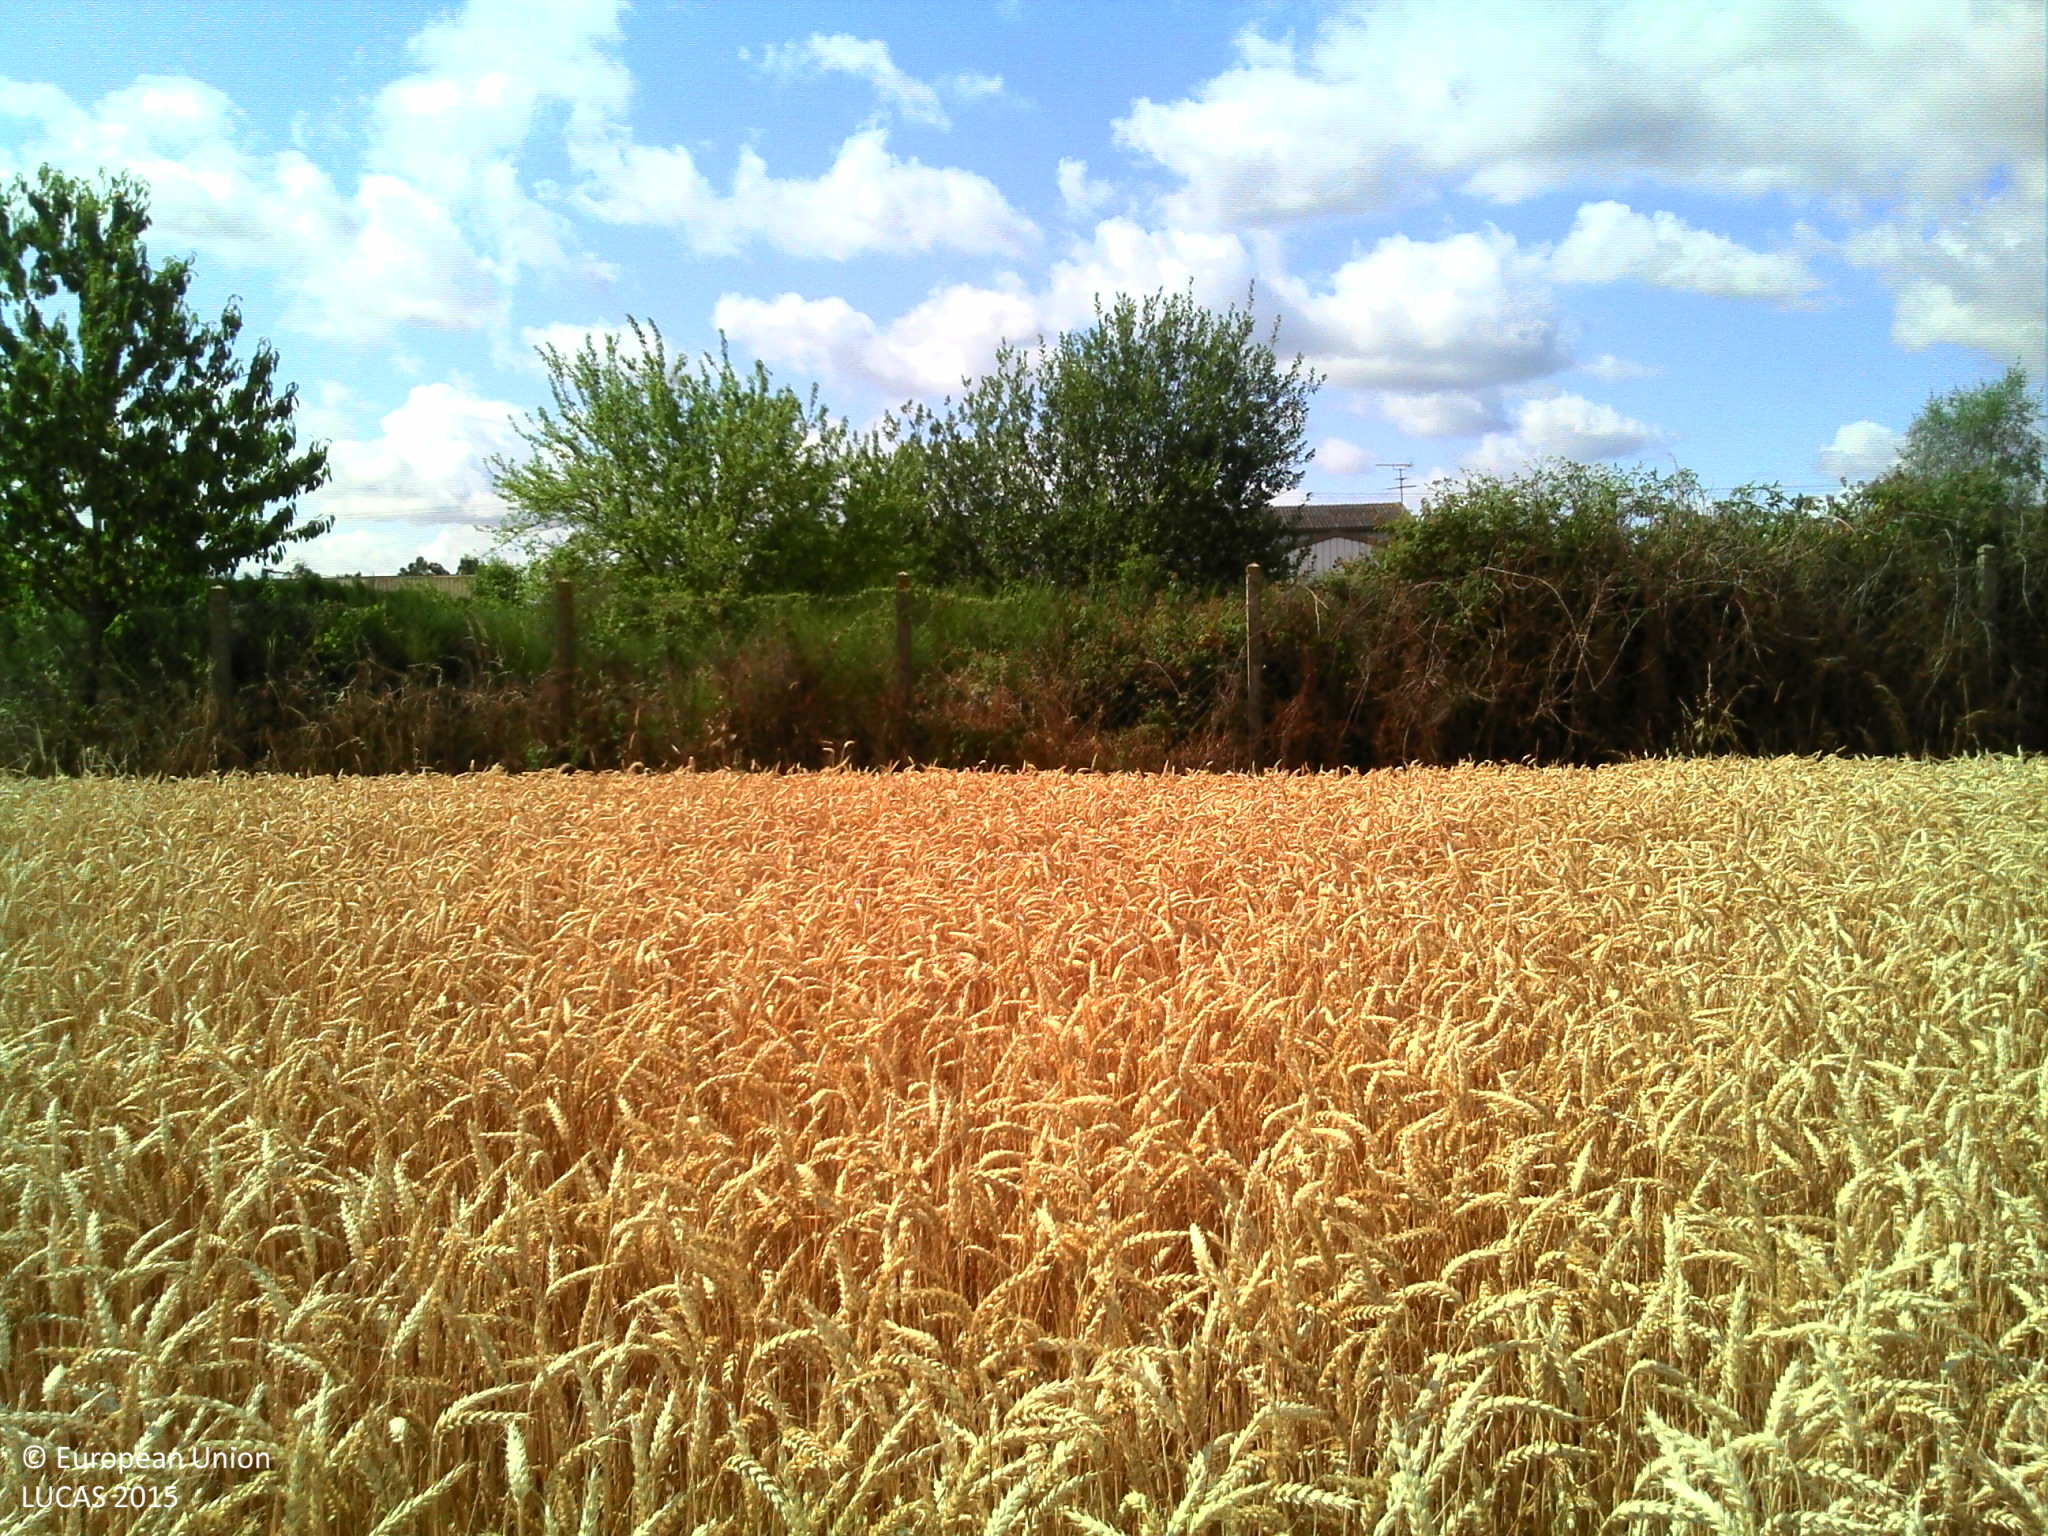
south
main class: Cropland
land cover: Common wheat
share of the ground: > 75 %
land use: Agriculture (excluding fallow land and kitchen gardens)
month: July
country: FR
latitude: 48.0969
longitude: 2.8080
